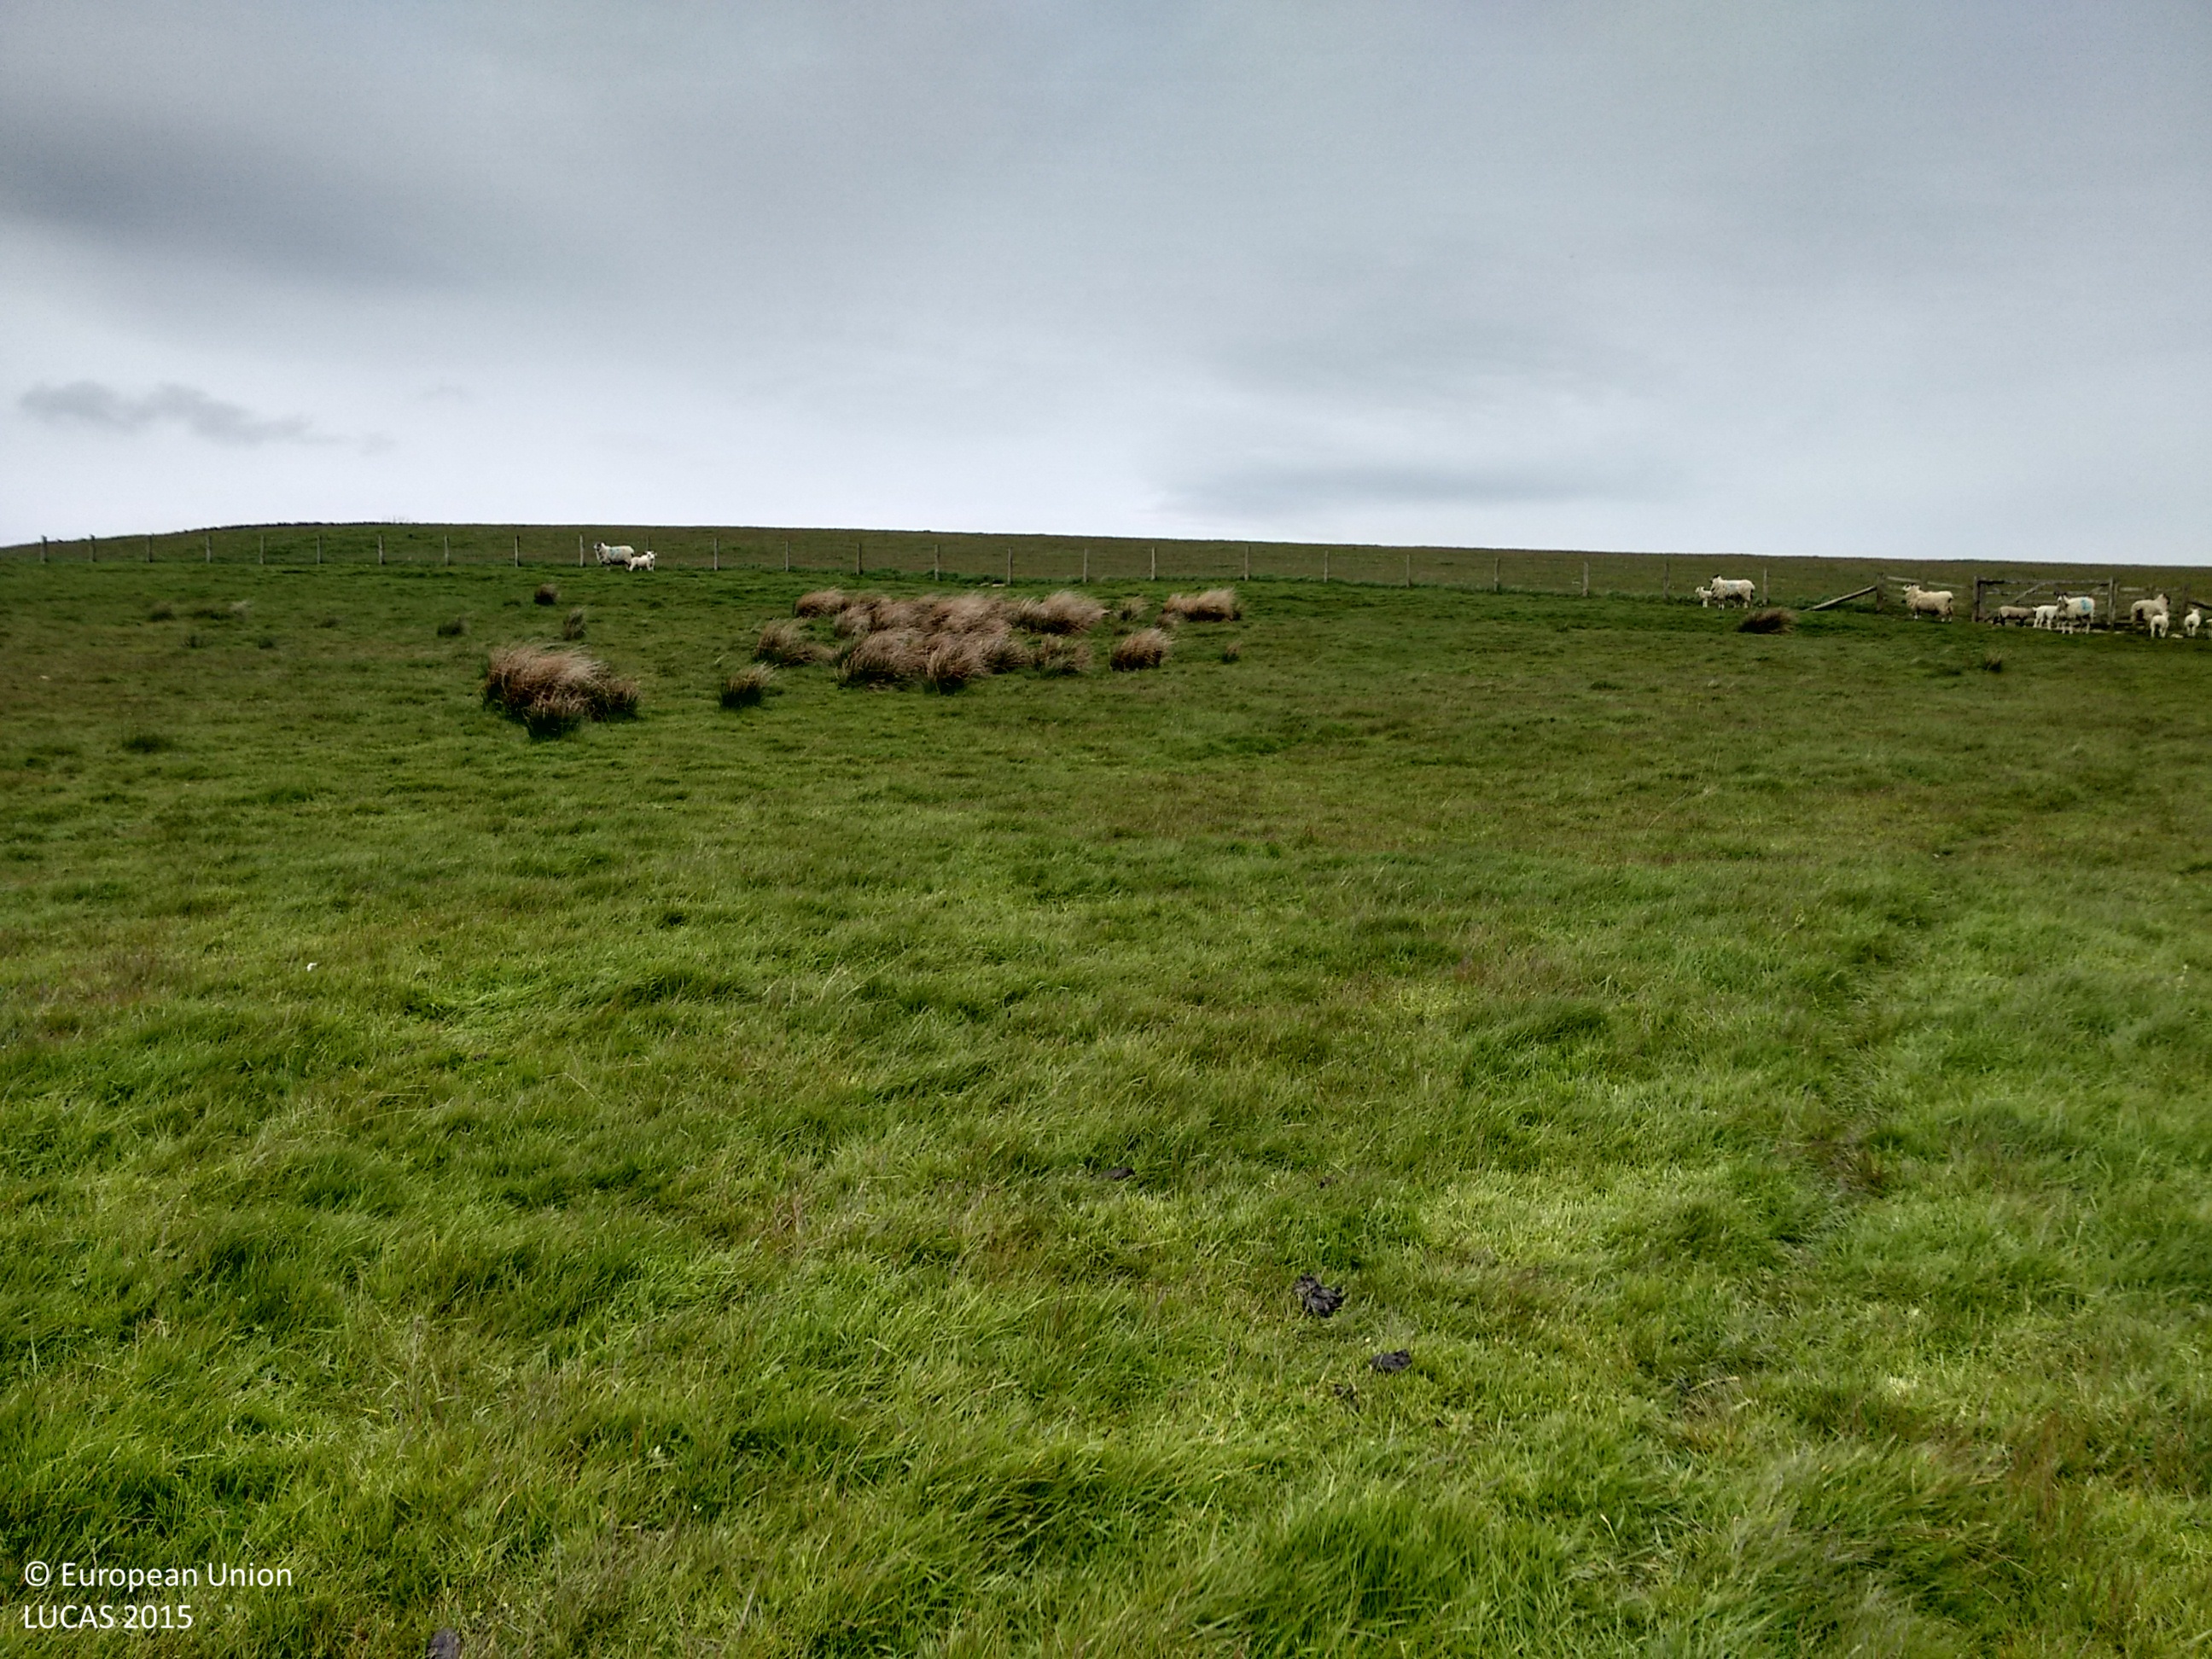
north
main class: Grassland
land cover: Grassland without tree/shrub cover
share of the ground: > 75 %
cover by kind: herbaceous plants 100 %
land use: Agriculture (excluding fallow land and kitchen gardens)
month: May
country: GB
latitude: 54.9073
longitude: -2.2398
